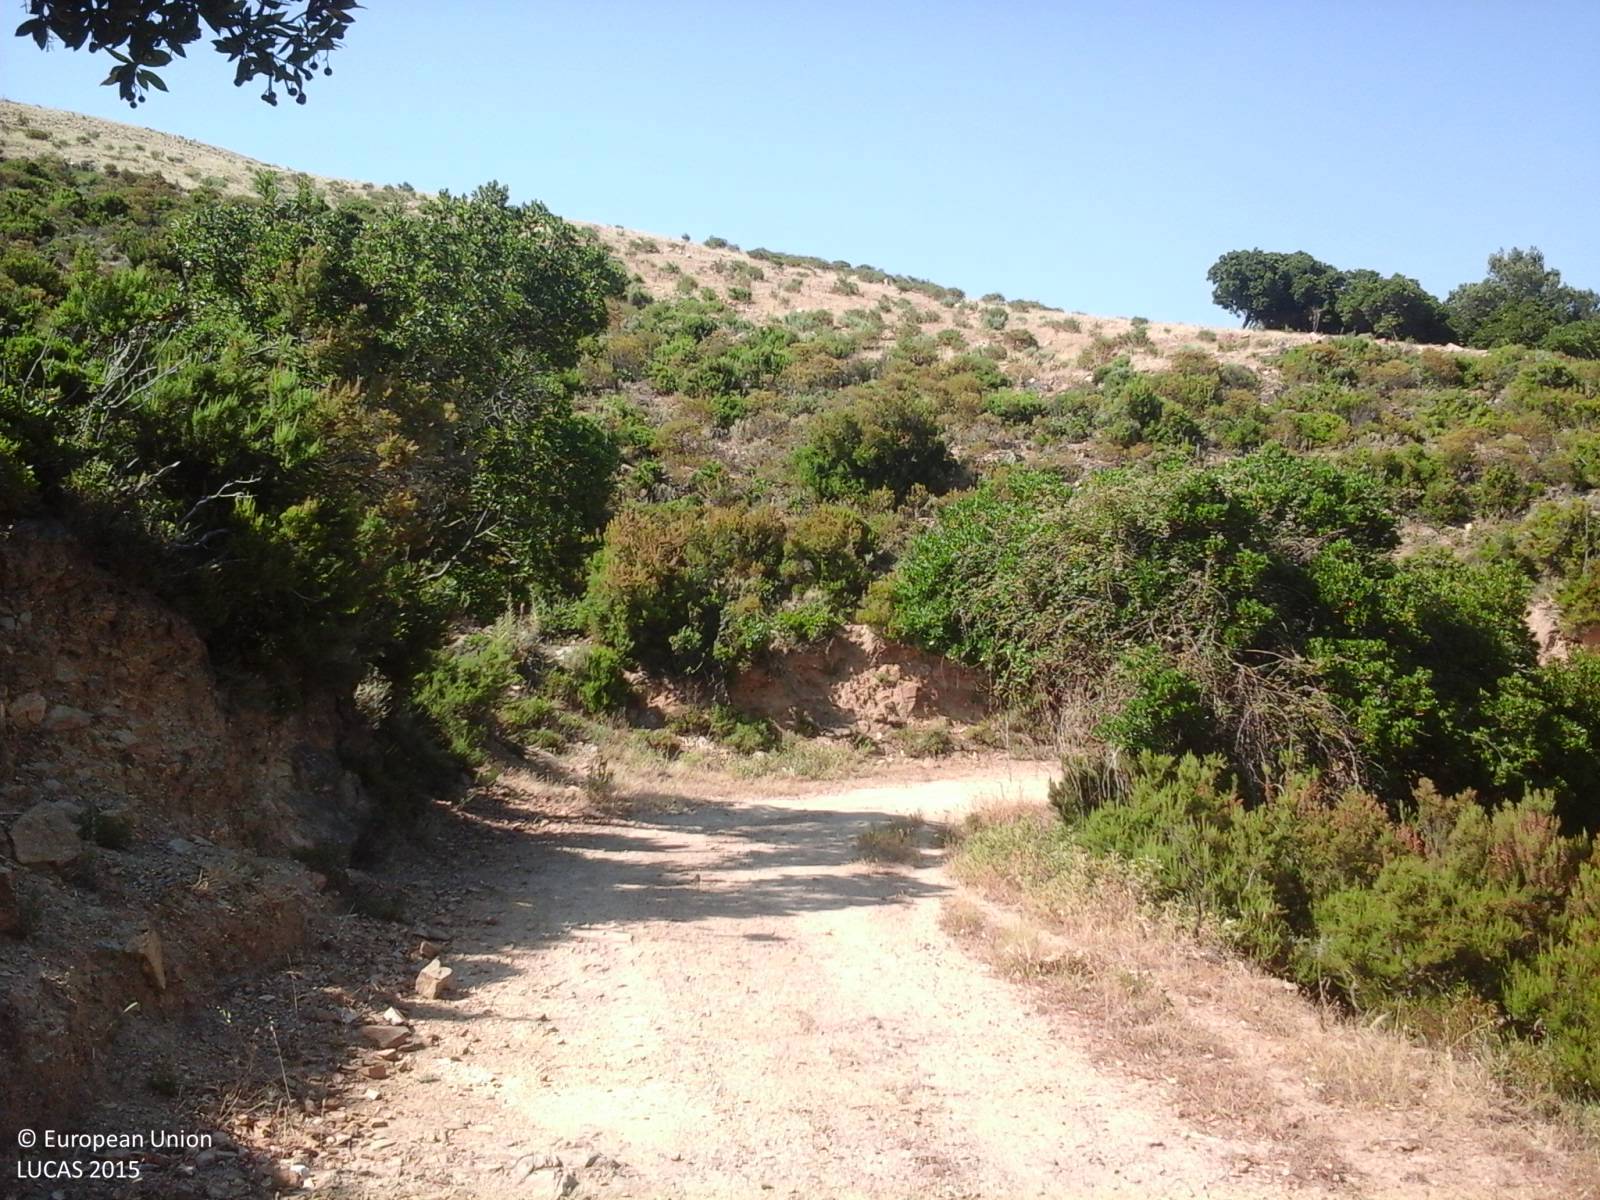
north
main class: Woodland
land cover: Broadleaved woodland
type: broadleaved evergreen forest
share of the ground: > 75 %
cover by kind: broadleaved forest trees 95 %, shrubs 5 %
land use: Semi-natural and natural areas not in use
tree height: > 5 m
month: June
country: IT
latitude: 40.5380
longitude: 9.5888
